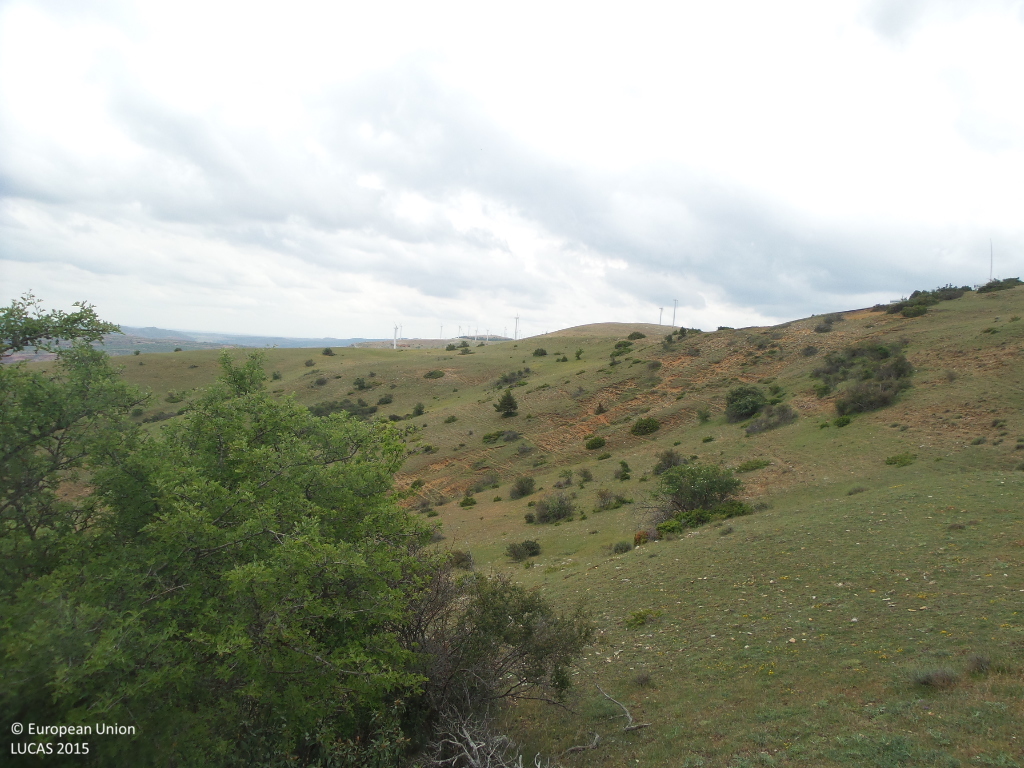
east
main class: Shrubland
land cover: Shrubland without tree cover
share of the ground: 10 - 25 %
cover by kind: herbaceous plants 85 %, shrubs 10 %, unconsolidated bare surface 5 %
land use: Agriculture (excluding fallow land and kitchen gardens)
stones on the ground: < 10 %
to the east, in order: Shrubland without tree cover; Grassland without tree/shrub cover
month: June
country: ES
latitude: 41.2969
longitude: -3.1658
